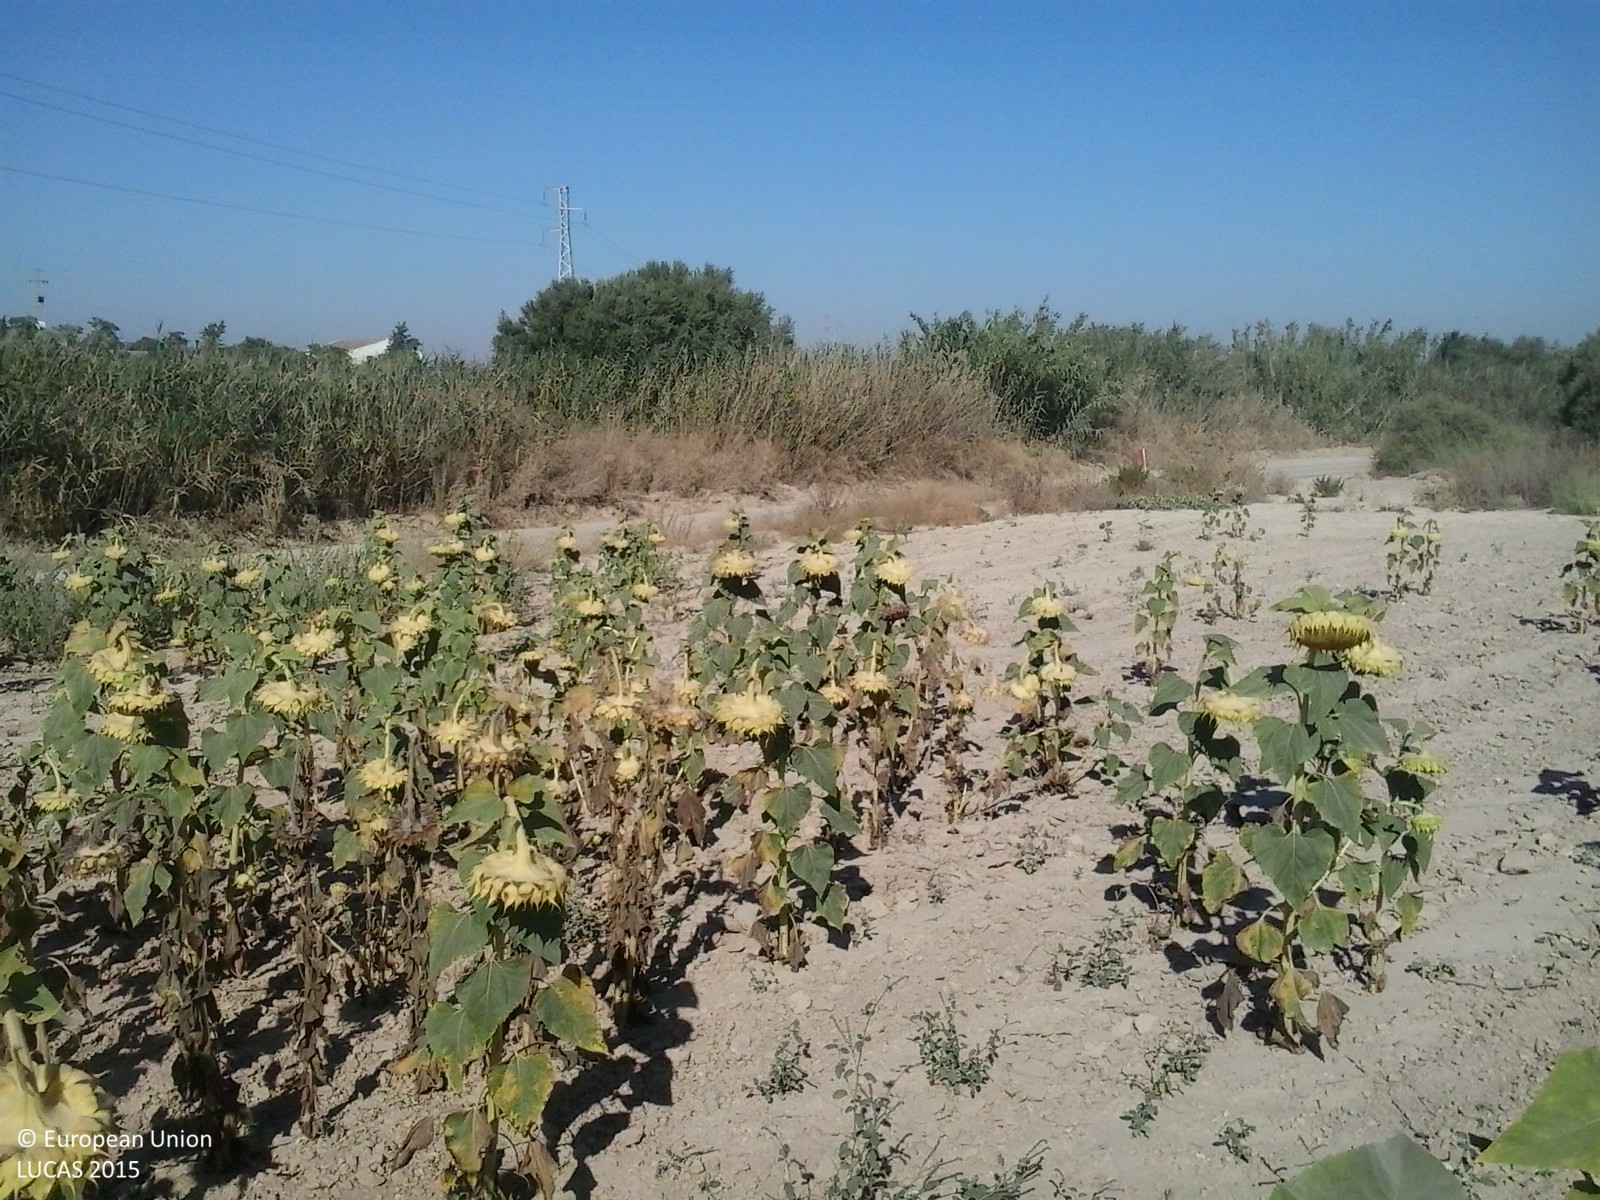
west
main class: Cropland
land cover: Sunflower
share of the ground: 10 - 25 %
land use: Agriculture (excluding fallow land and kitchen gardens)
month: July
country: ES
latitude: 36.8670
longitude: -5.9758
